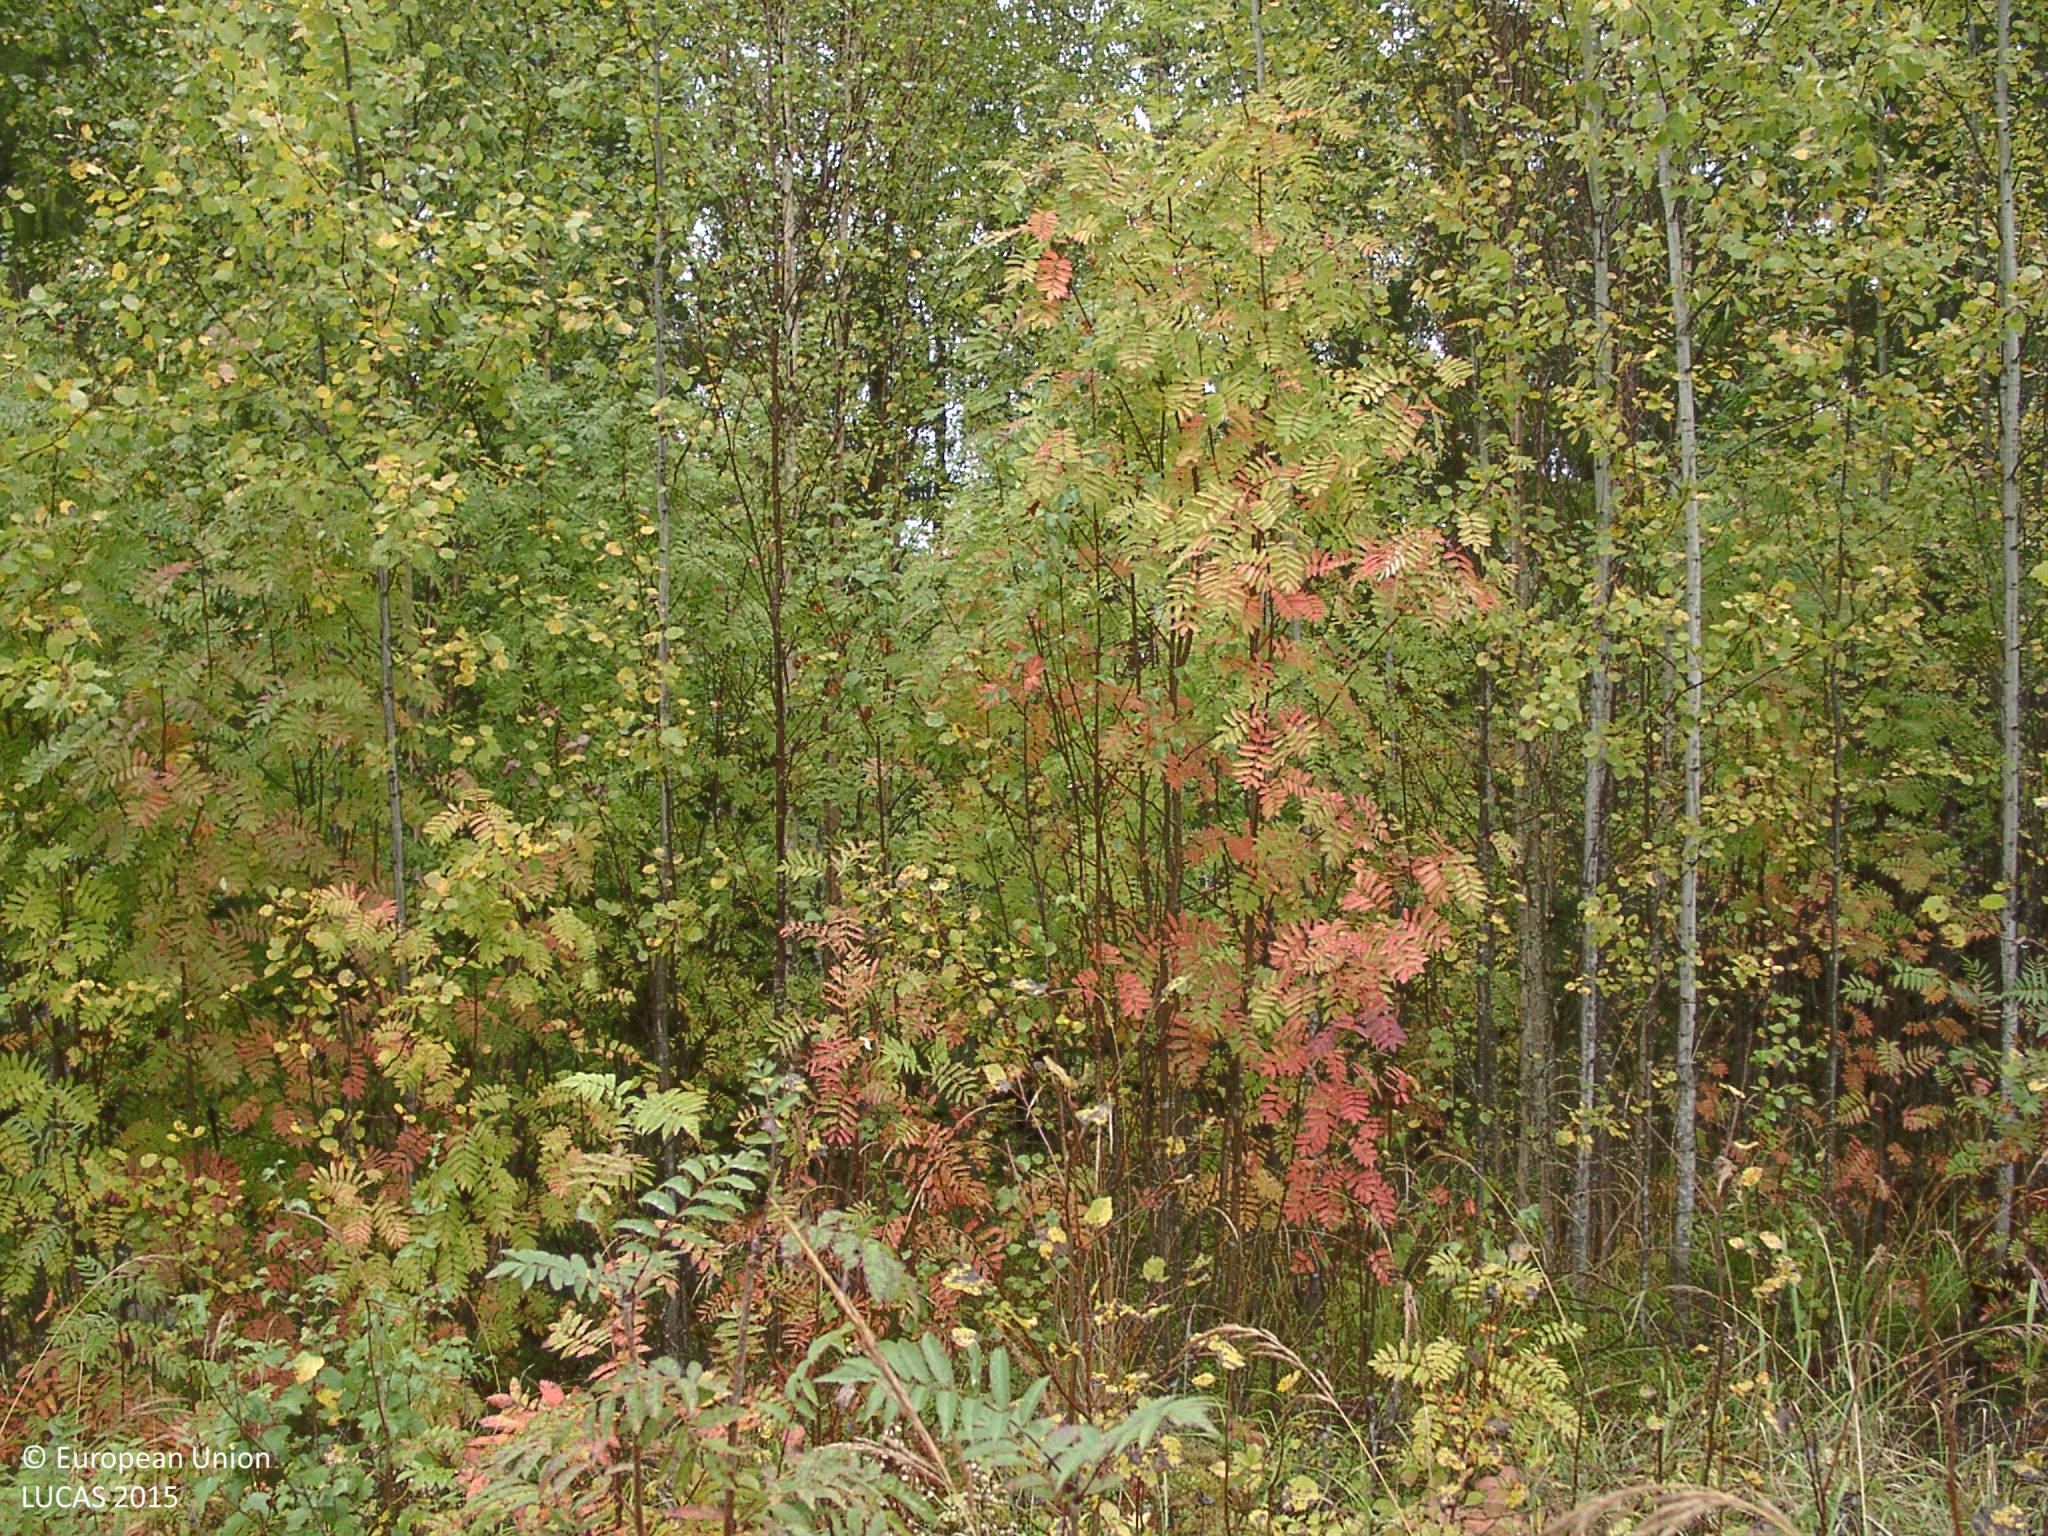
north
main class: Woodland
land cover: Broadleaved woodland
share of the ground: 25 - 50 %
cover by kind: herbaceous plants 60 %, broadleaved forest trees 35 %, shrubs 5 %
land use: Electricity, gas and thermal power distribution
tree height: < 5 m
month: September
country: FI
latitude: 62.5861
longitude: 25.5907
